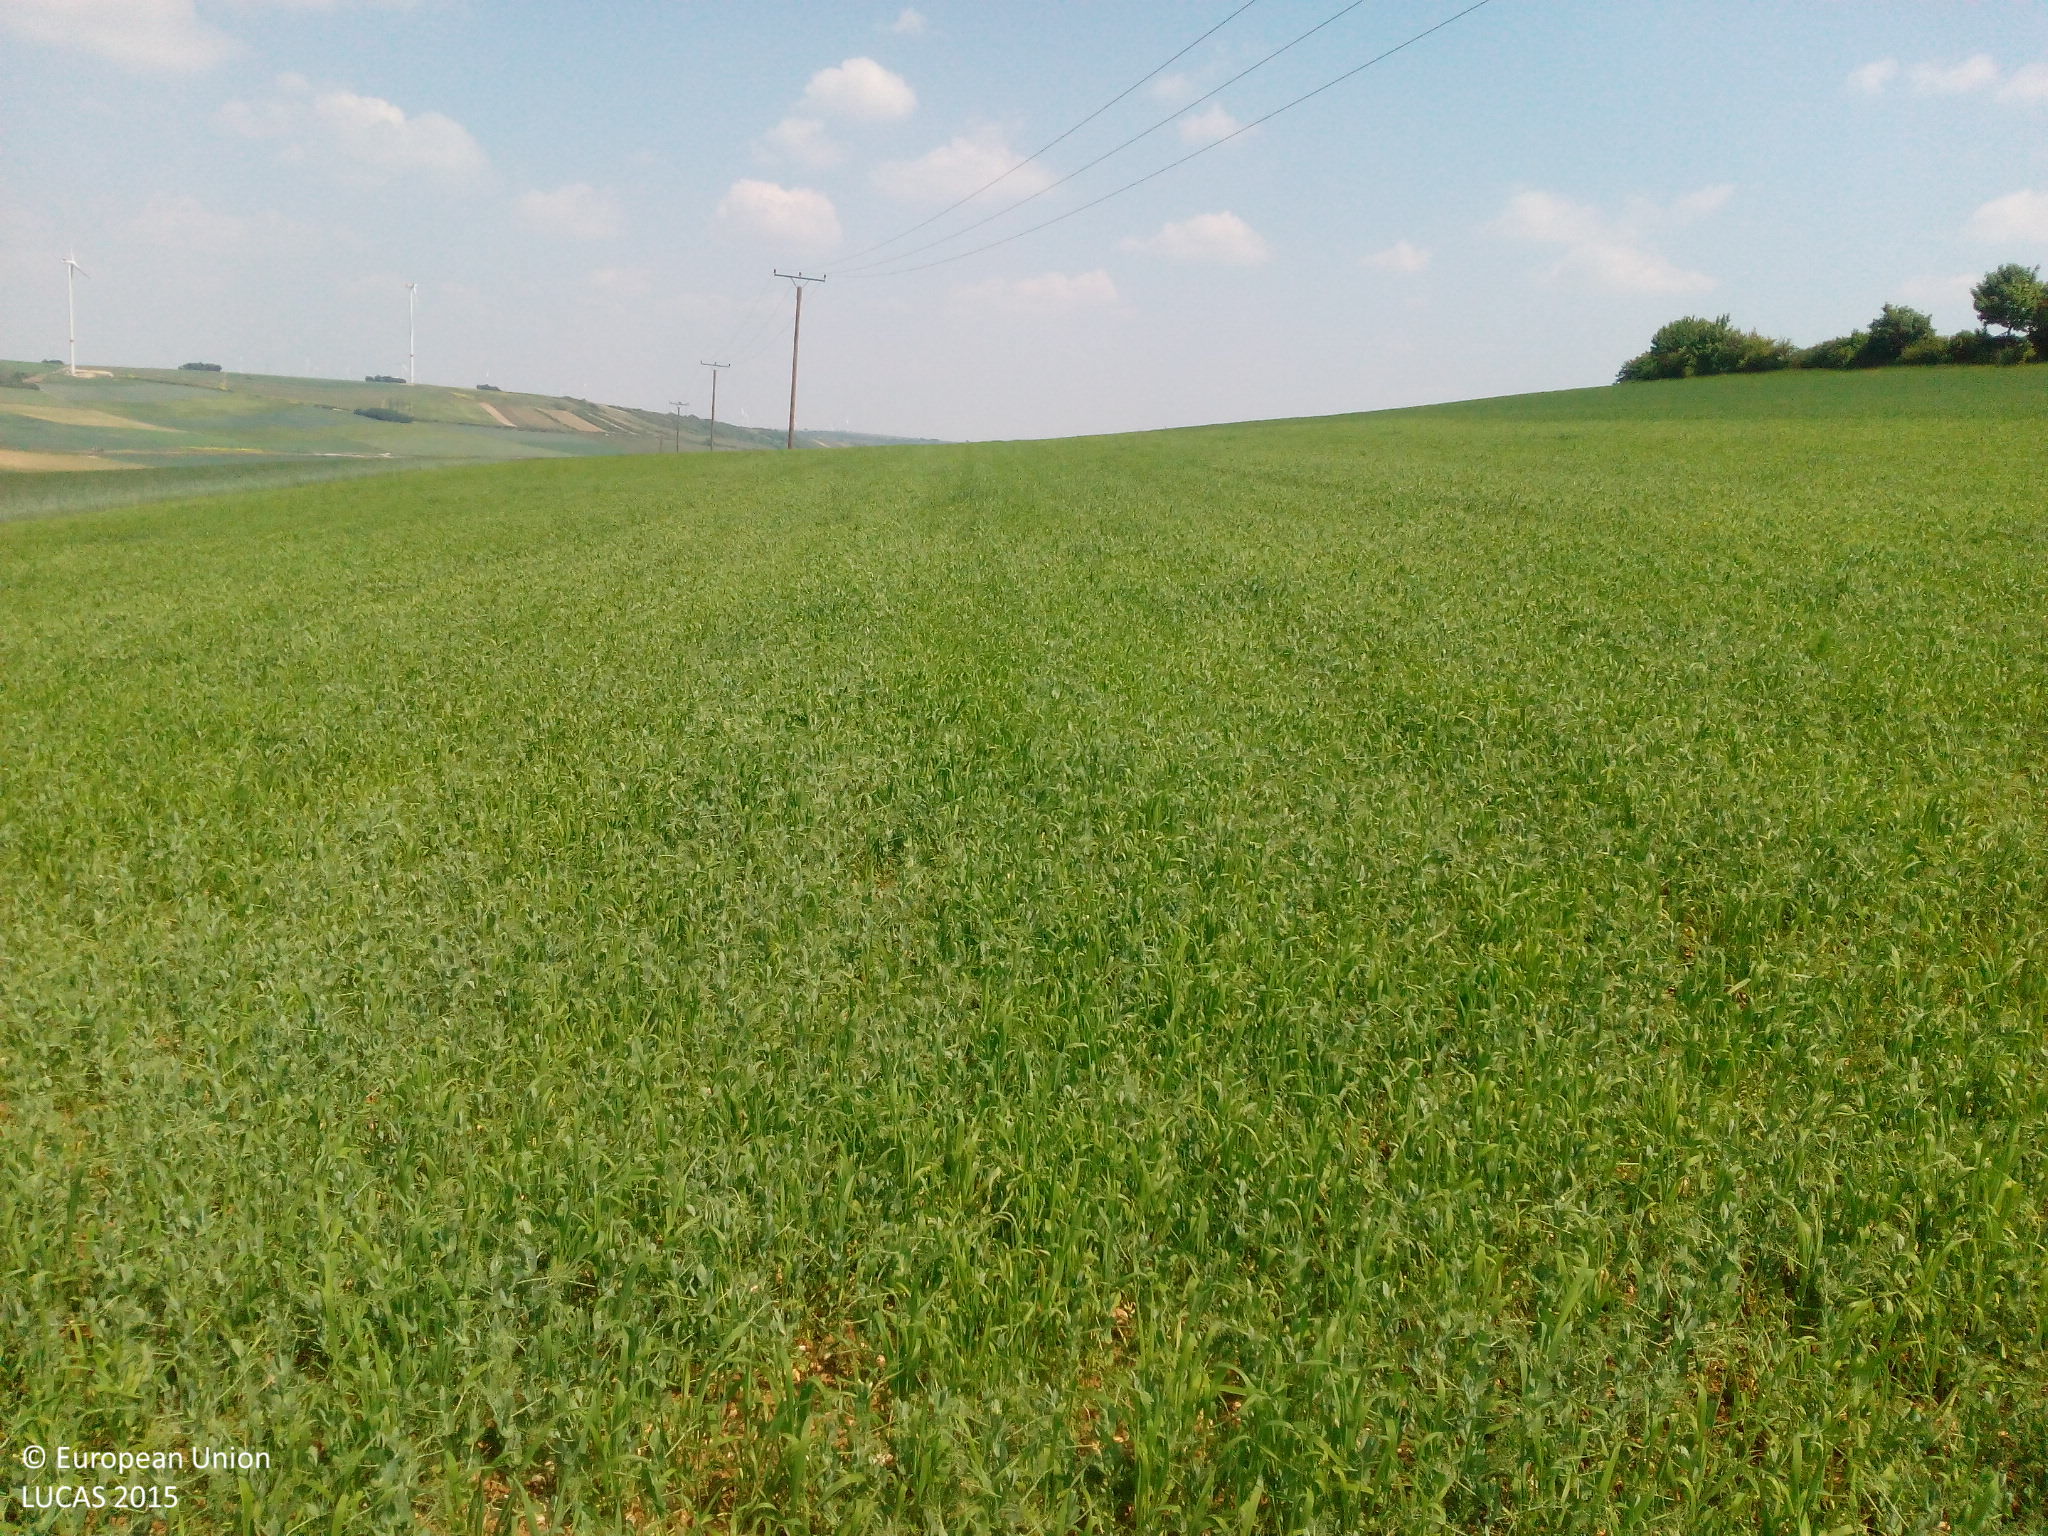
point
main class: Cropland
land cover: Other leguminous and mixtures for fodder
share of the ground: 50 - 75 %
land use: Agriculture (excluding fallow land and kitchen gardens)
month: May
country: DE
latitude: 49.6279
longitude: 8.0484
